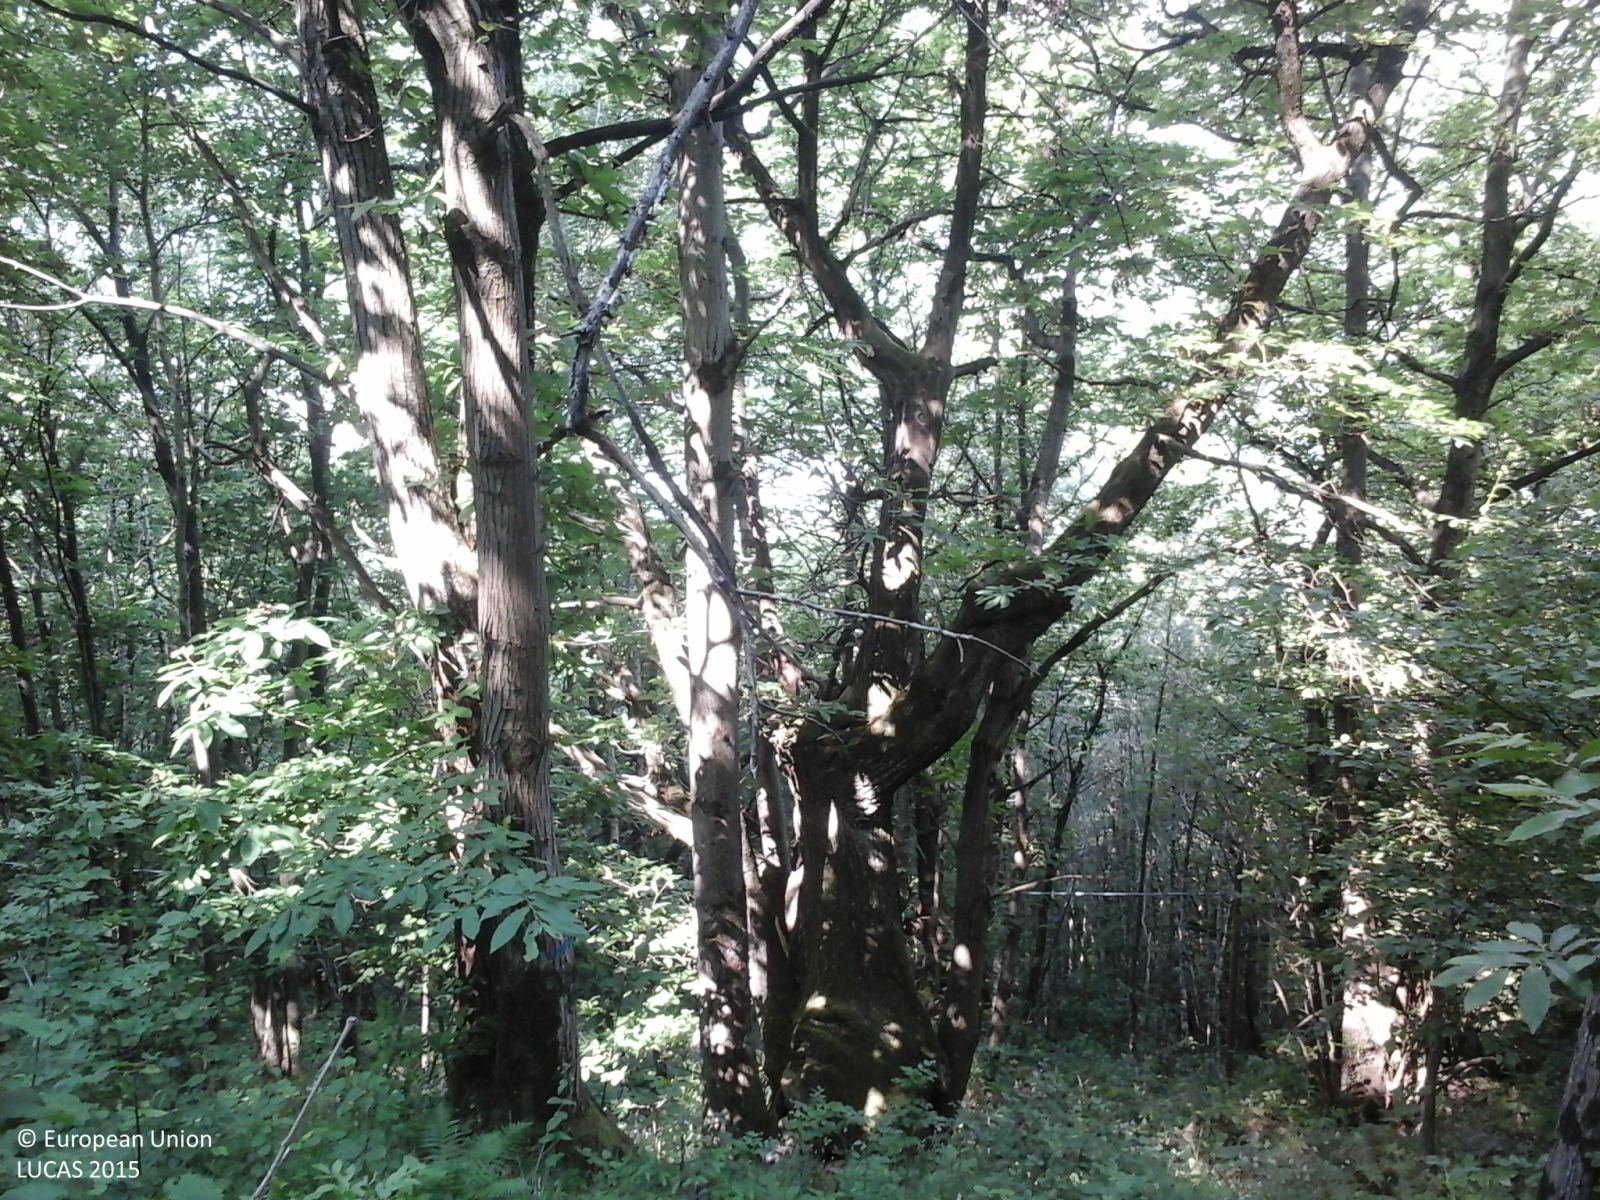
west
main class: Woodland
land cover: Broadleaved woodland
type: thermophilous deciduous forest
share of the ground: > 75 %
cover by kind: broadleaved forest trees 100 %
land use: Semi-natural and natural areas not in use
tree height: > 5 m
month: June
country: IT
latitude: 46.1345
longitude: 10.3490
